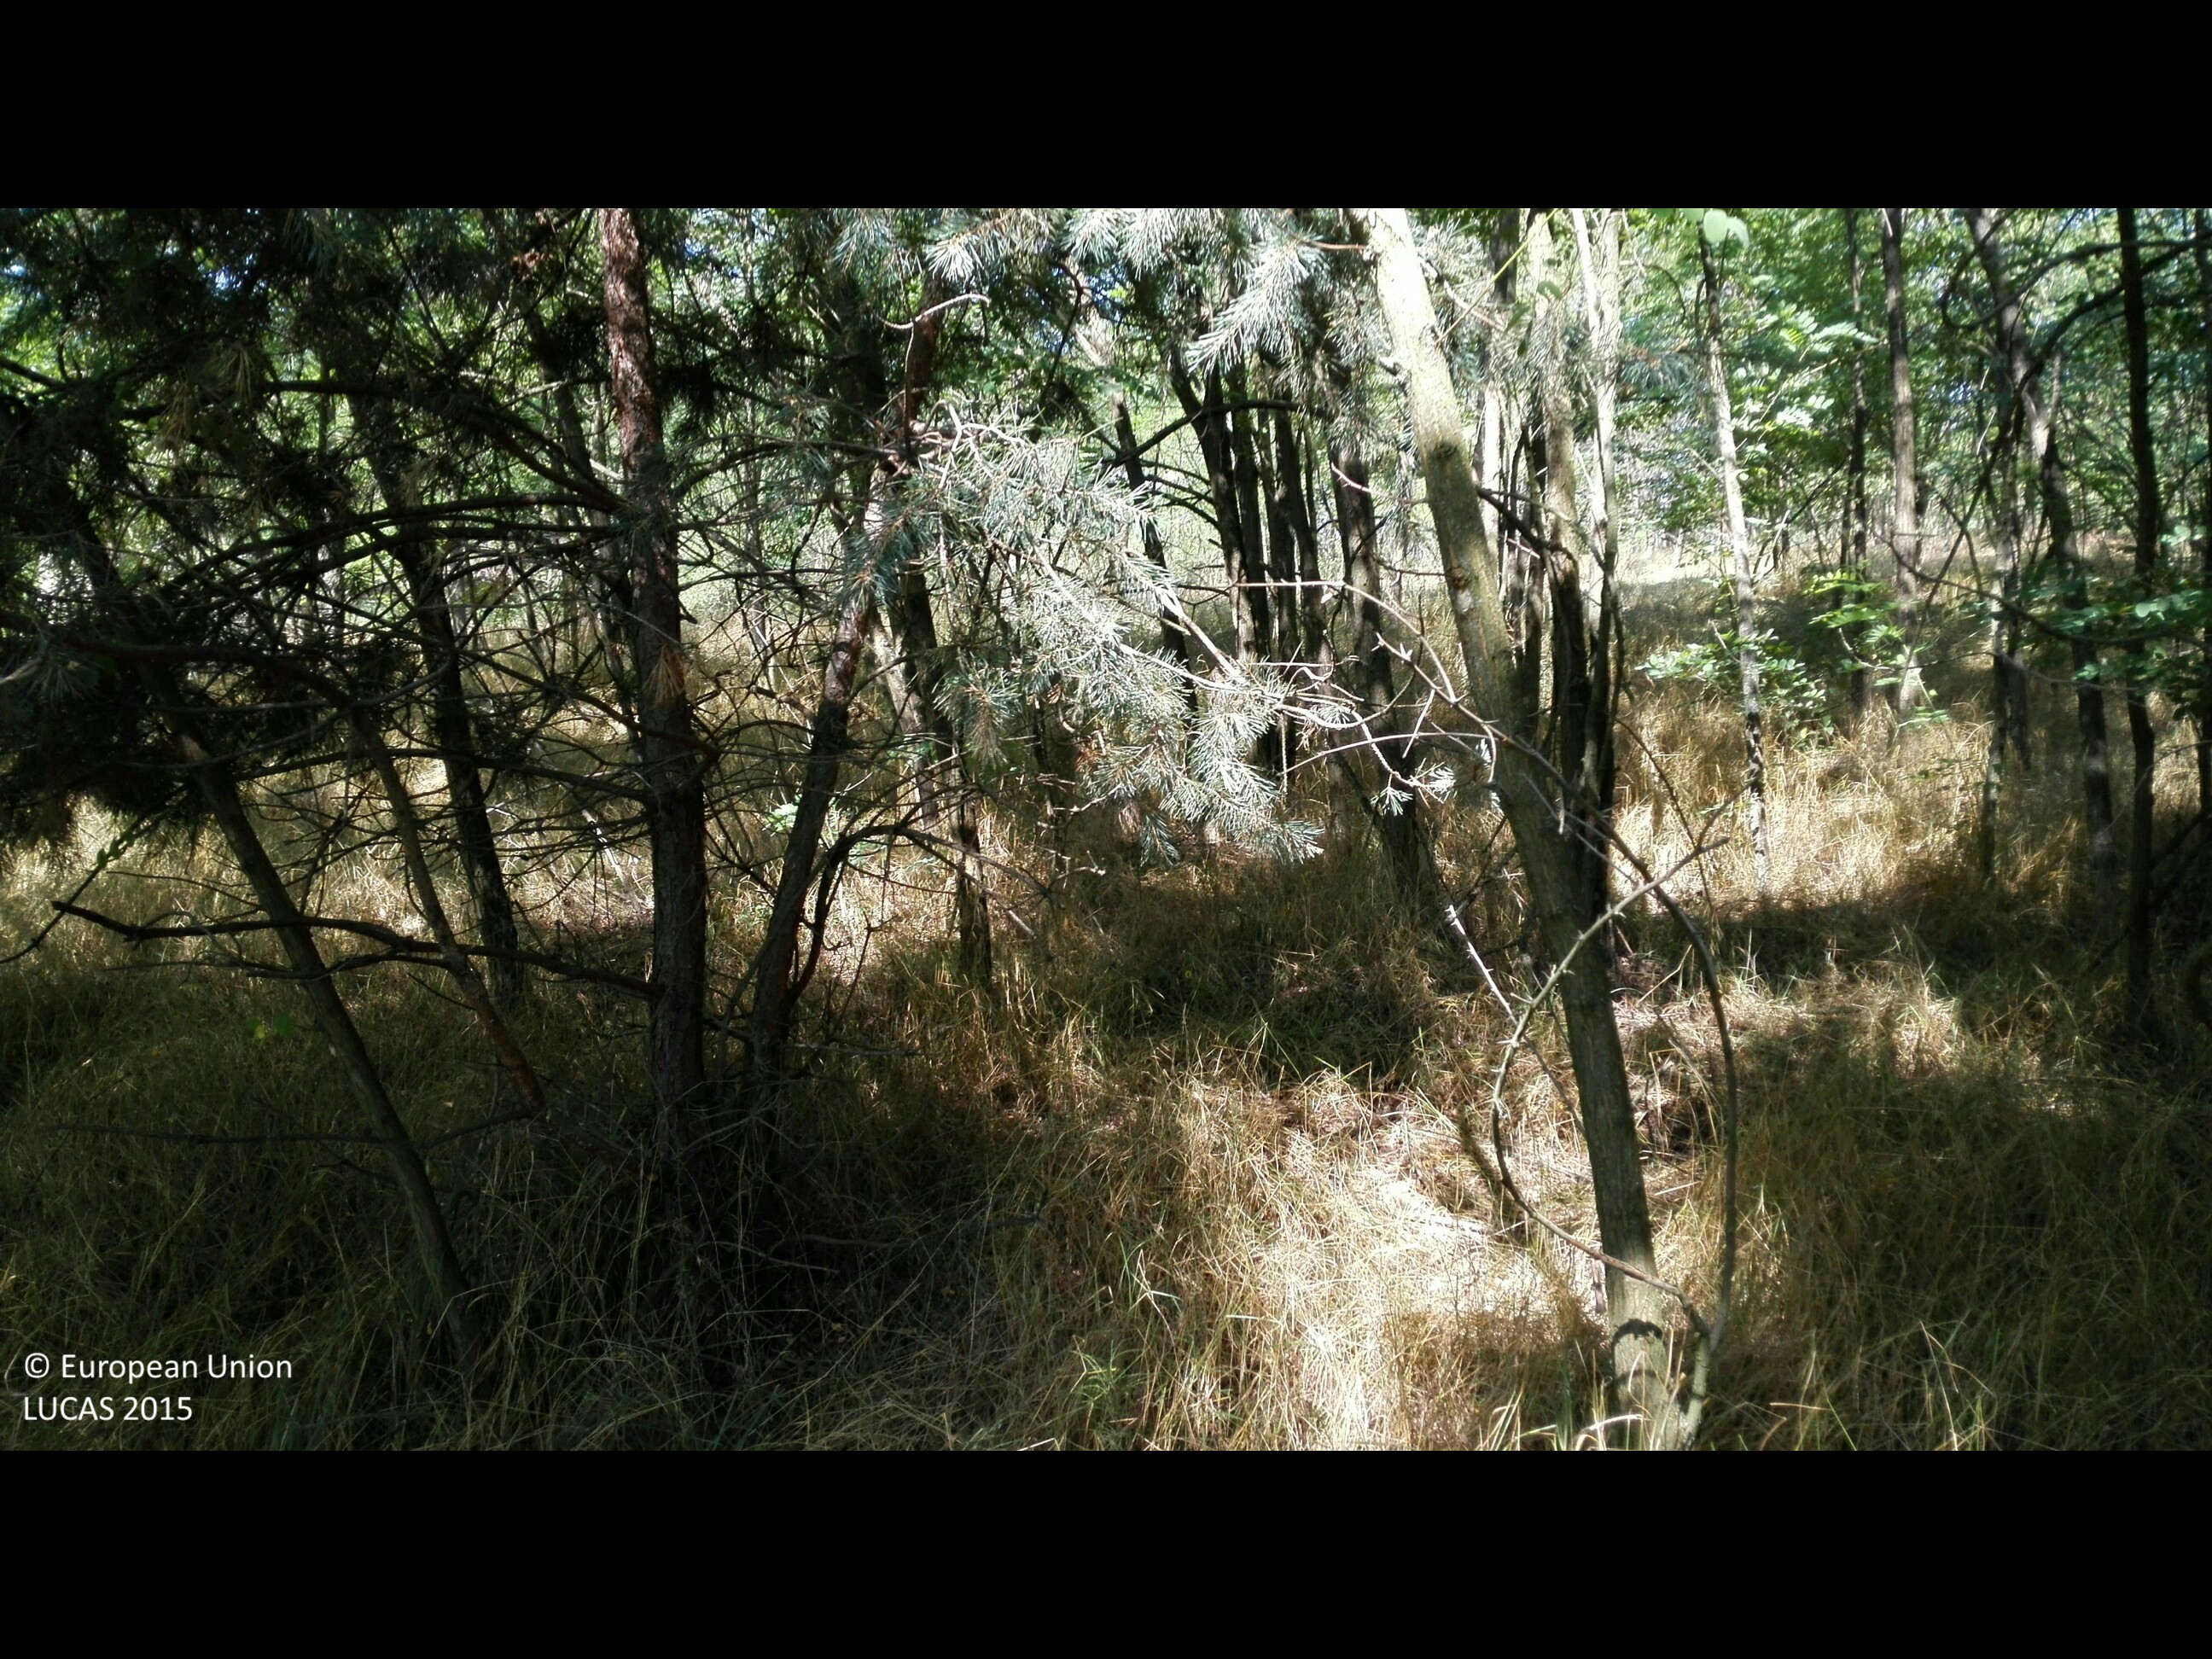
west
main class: Woodland
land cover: Broadleaved woodland
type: exotic forest
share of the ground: > 75 %
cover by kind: broadleaved forest trees 90 %, coniferous forest trees 5 %, herbaceous plants 5 %
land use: Forestry
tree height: > 5 m
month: August
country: HU
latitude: 47.6334
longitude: 22.0421
